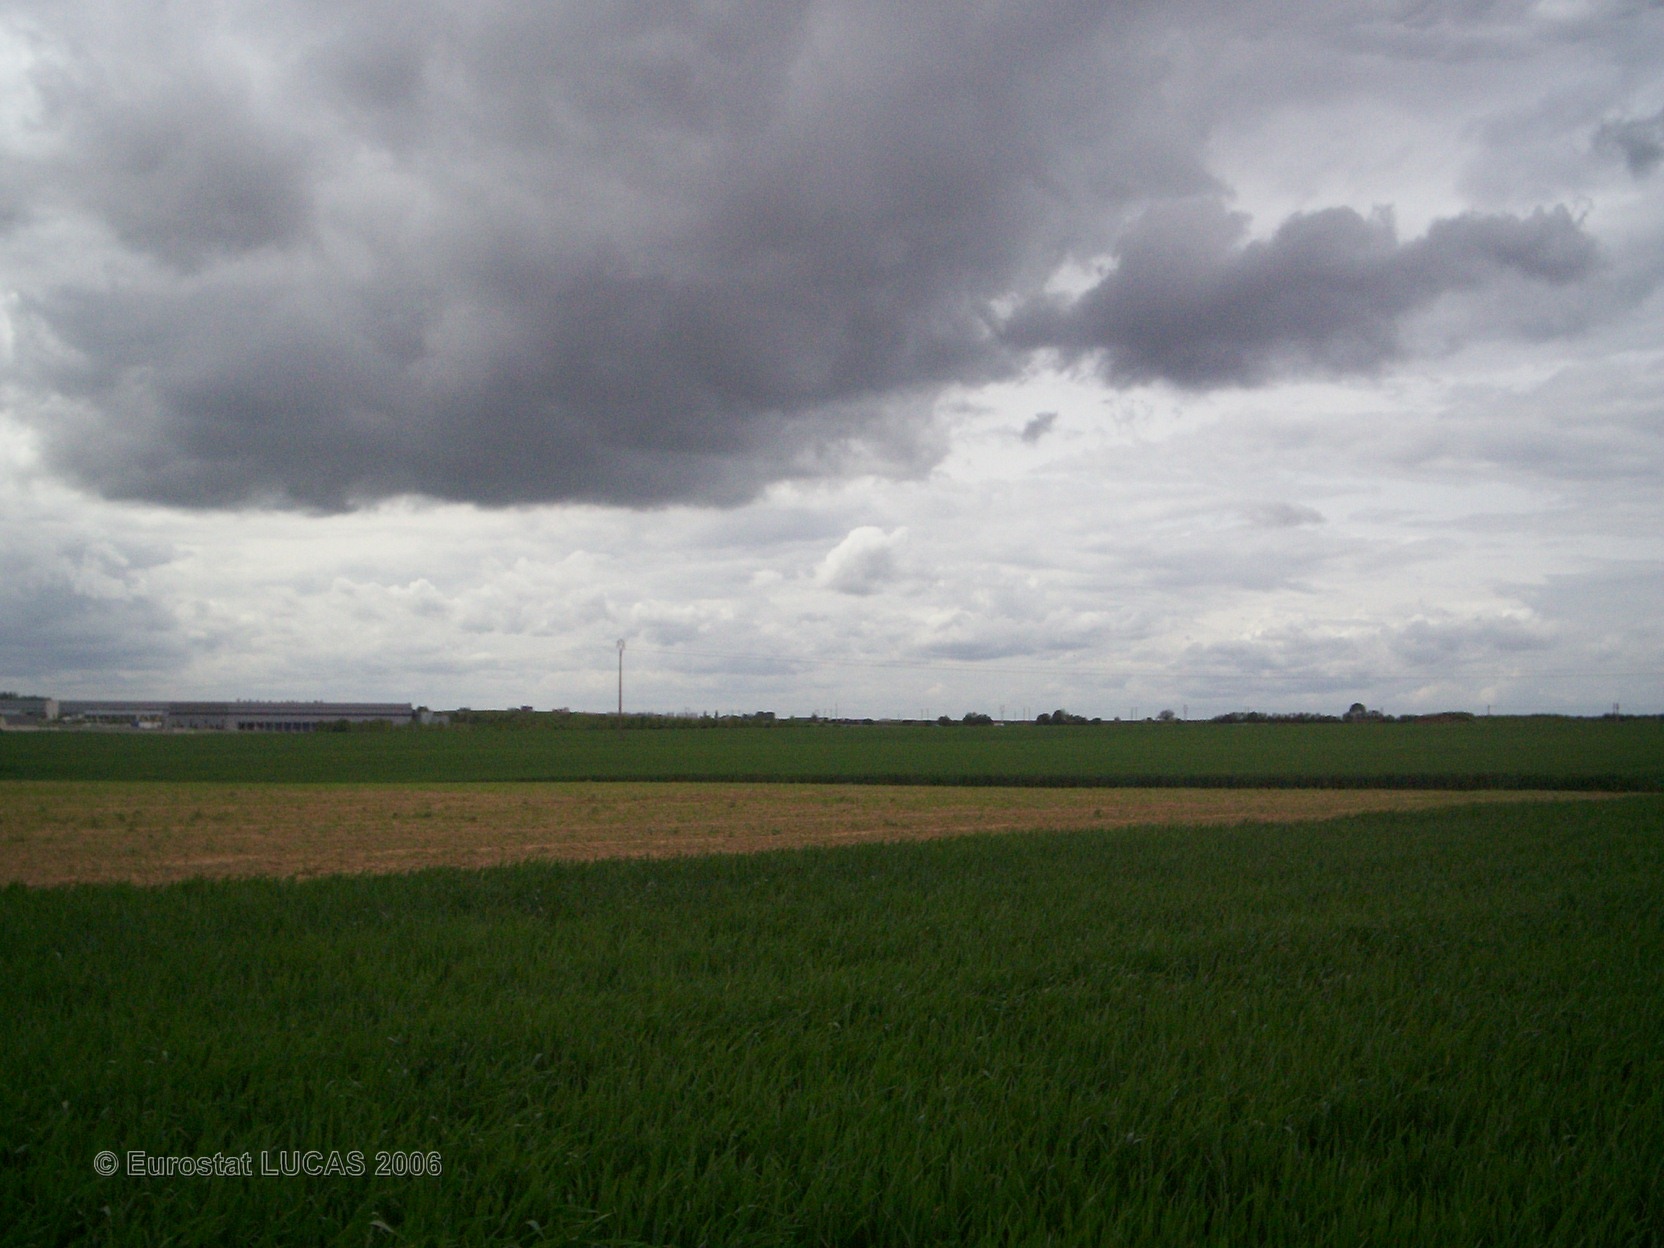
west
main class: Cropland
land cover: Common wheat
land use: Agriculture (excluding fallow land and kitchen gardens)
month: May
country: FR
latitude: 49.1060
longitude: 2.7710
